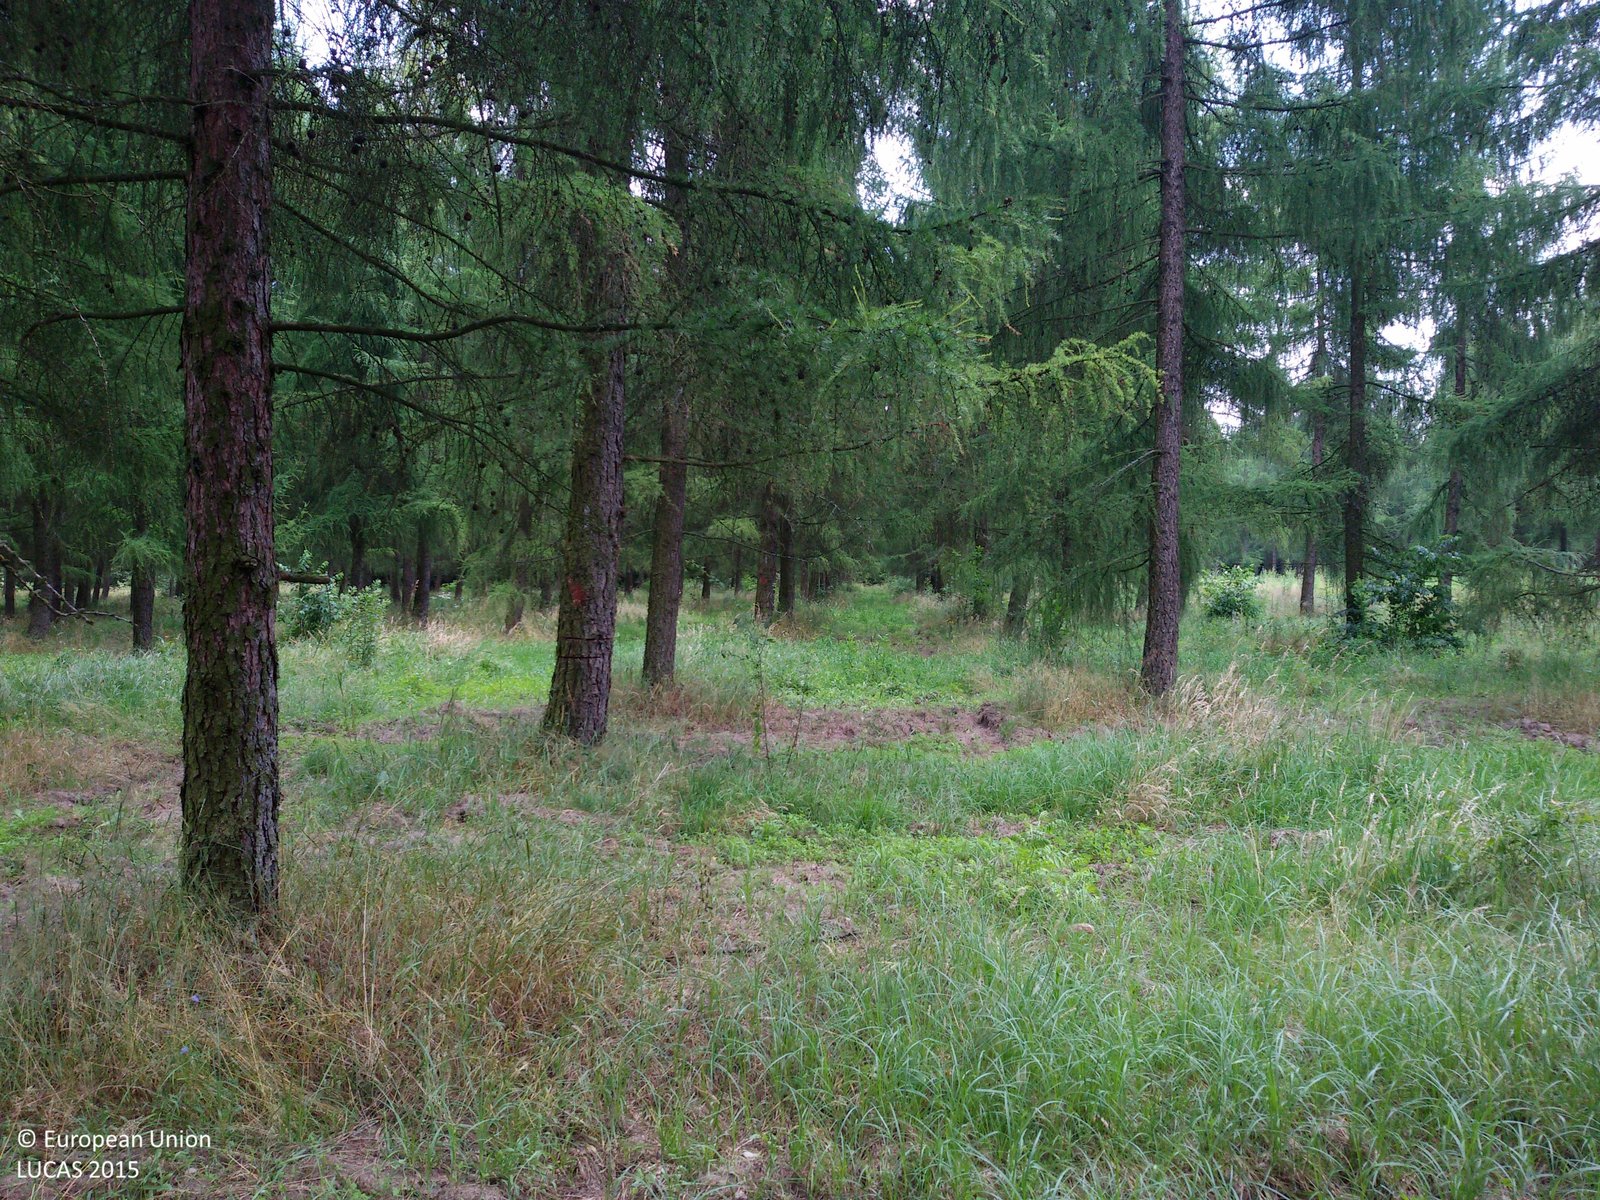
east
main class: Woodland
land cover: Other coniferous woodland
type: hemiboreal forest and nemoral coniferous forest and mixed broadleaved-coniferous forest
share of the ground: 50 - 75 %
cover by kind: coniferous forest trees 70 %, herbaceous plants 20 %, shrubs 5 %, unconsolidated bare surface 5 %
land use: Forestry
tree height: > 5 m
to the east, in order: Other coniferous woodland; Spruce dominated coniferous woodland
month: July
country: PL
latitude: 51.6972
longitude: 19.8260
